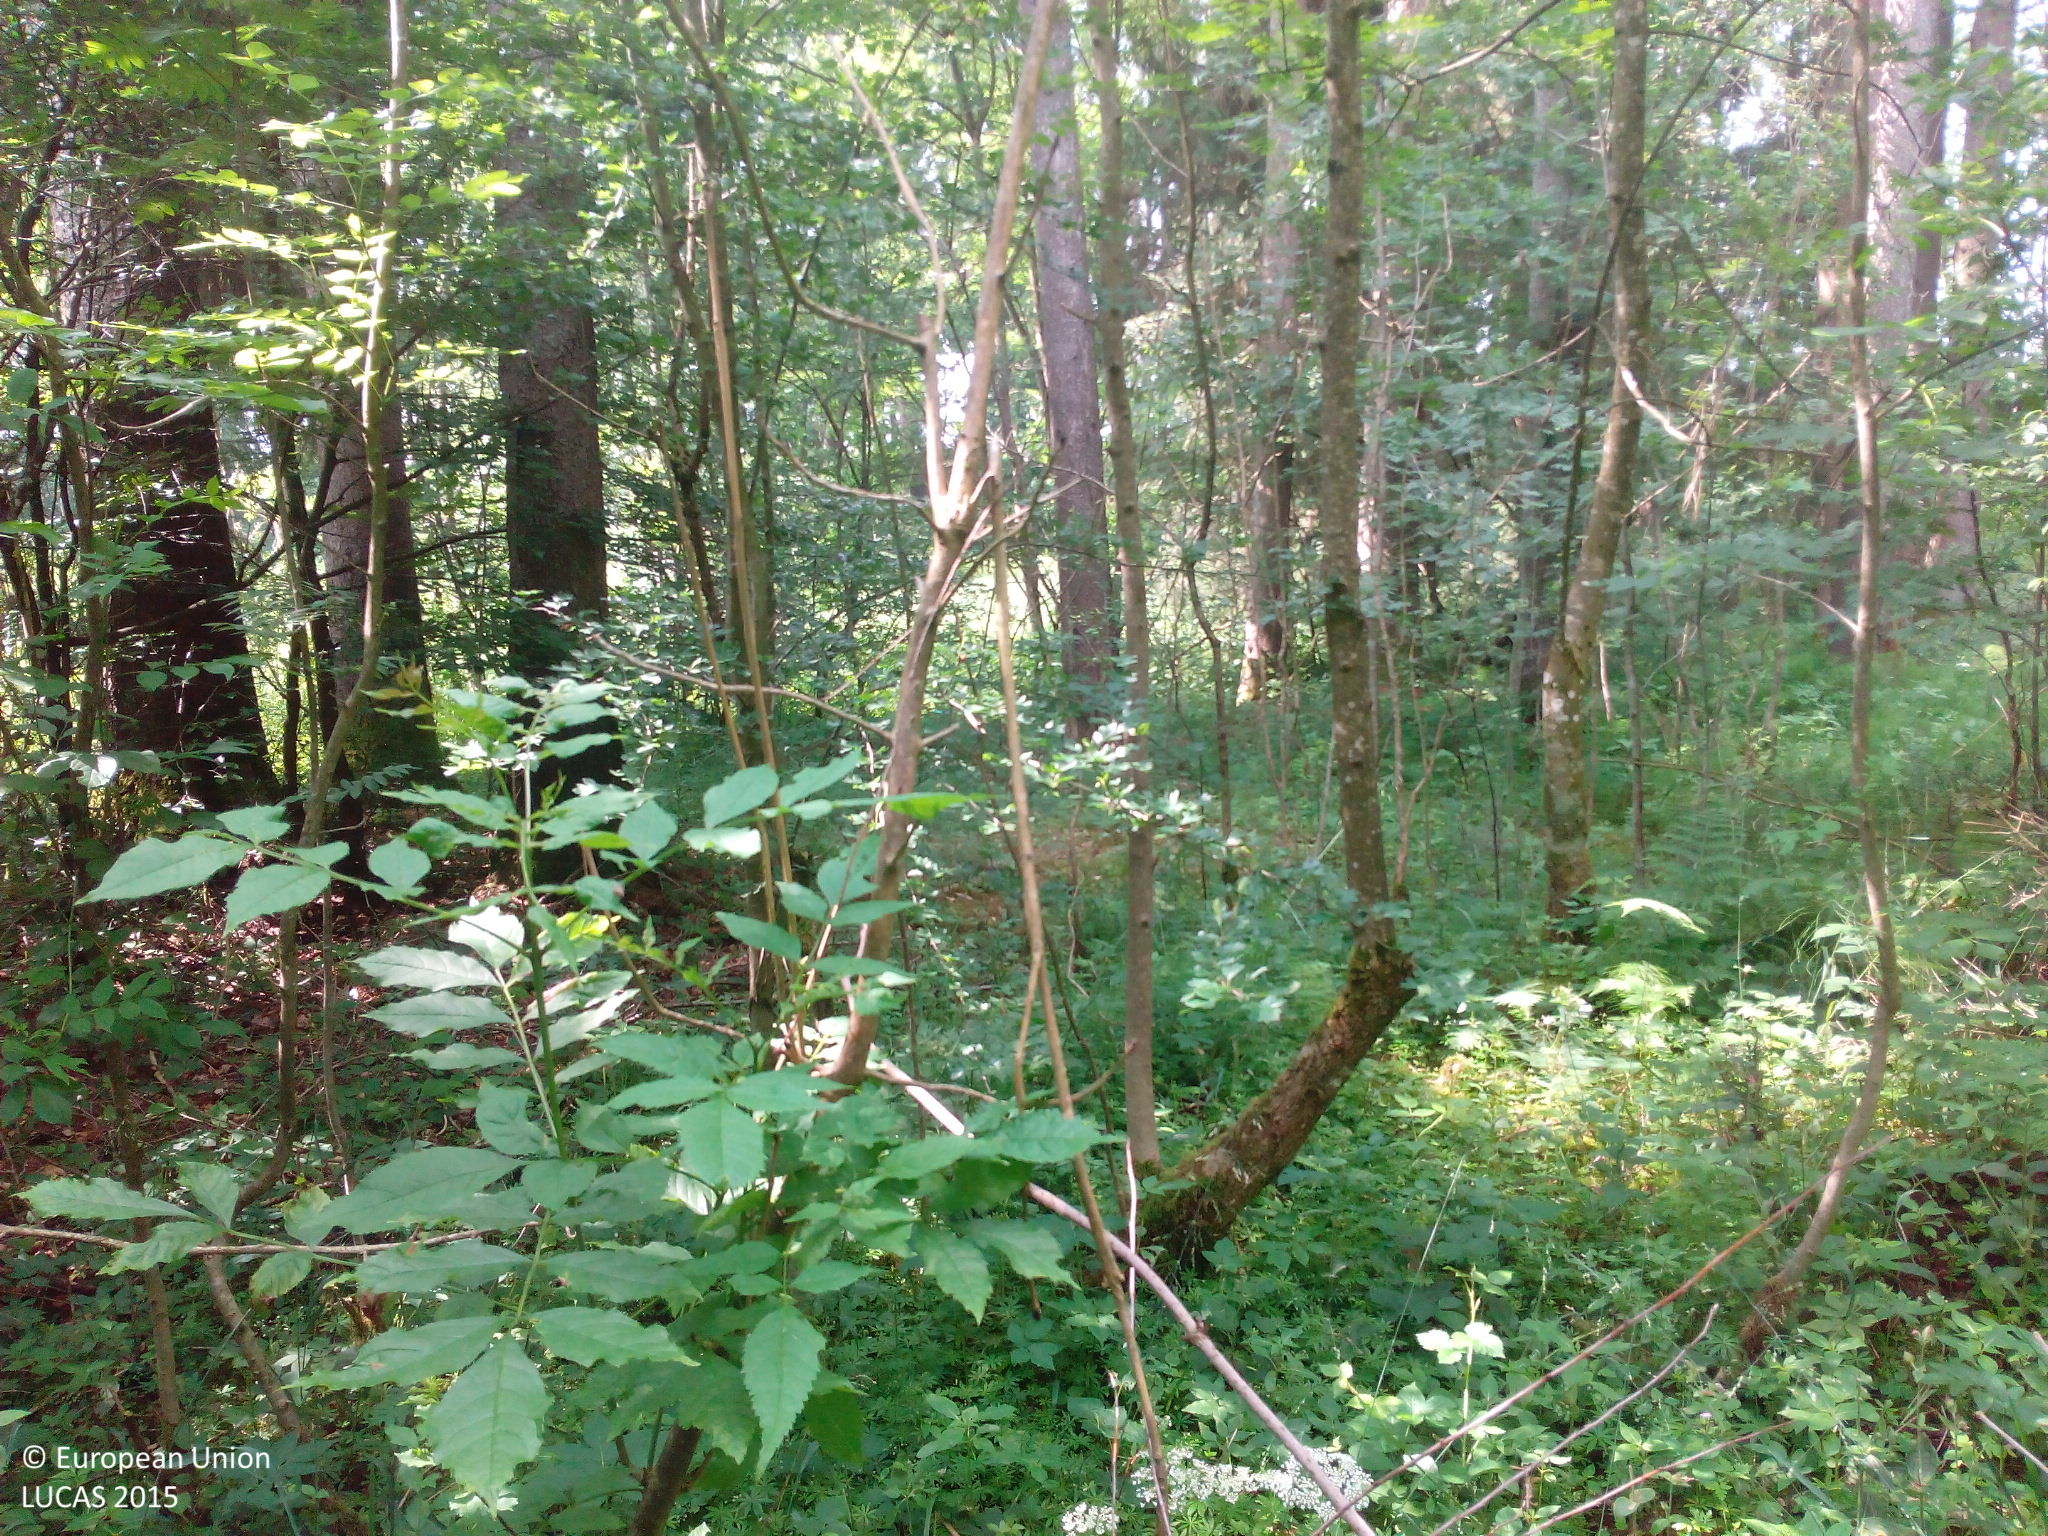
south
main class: Woodland
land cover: Other mixed woodland
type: hemiboreal forest and nemoral coniferous forest and mixed broadleaved-coniferous forest
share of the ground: > 75 %
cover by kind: broadleaved forest trees 55 %, coniferous forest trees 25 %, shrubs 10 %, herbaceous plants 10 %
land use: Forestry
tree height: > 5 m
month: June
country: DE
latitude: 47.7196
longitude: 9.9334
